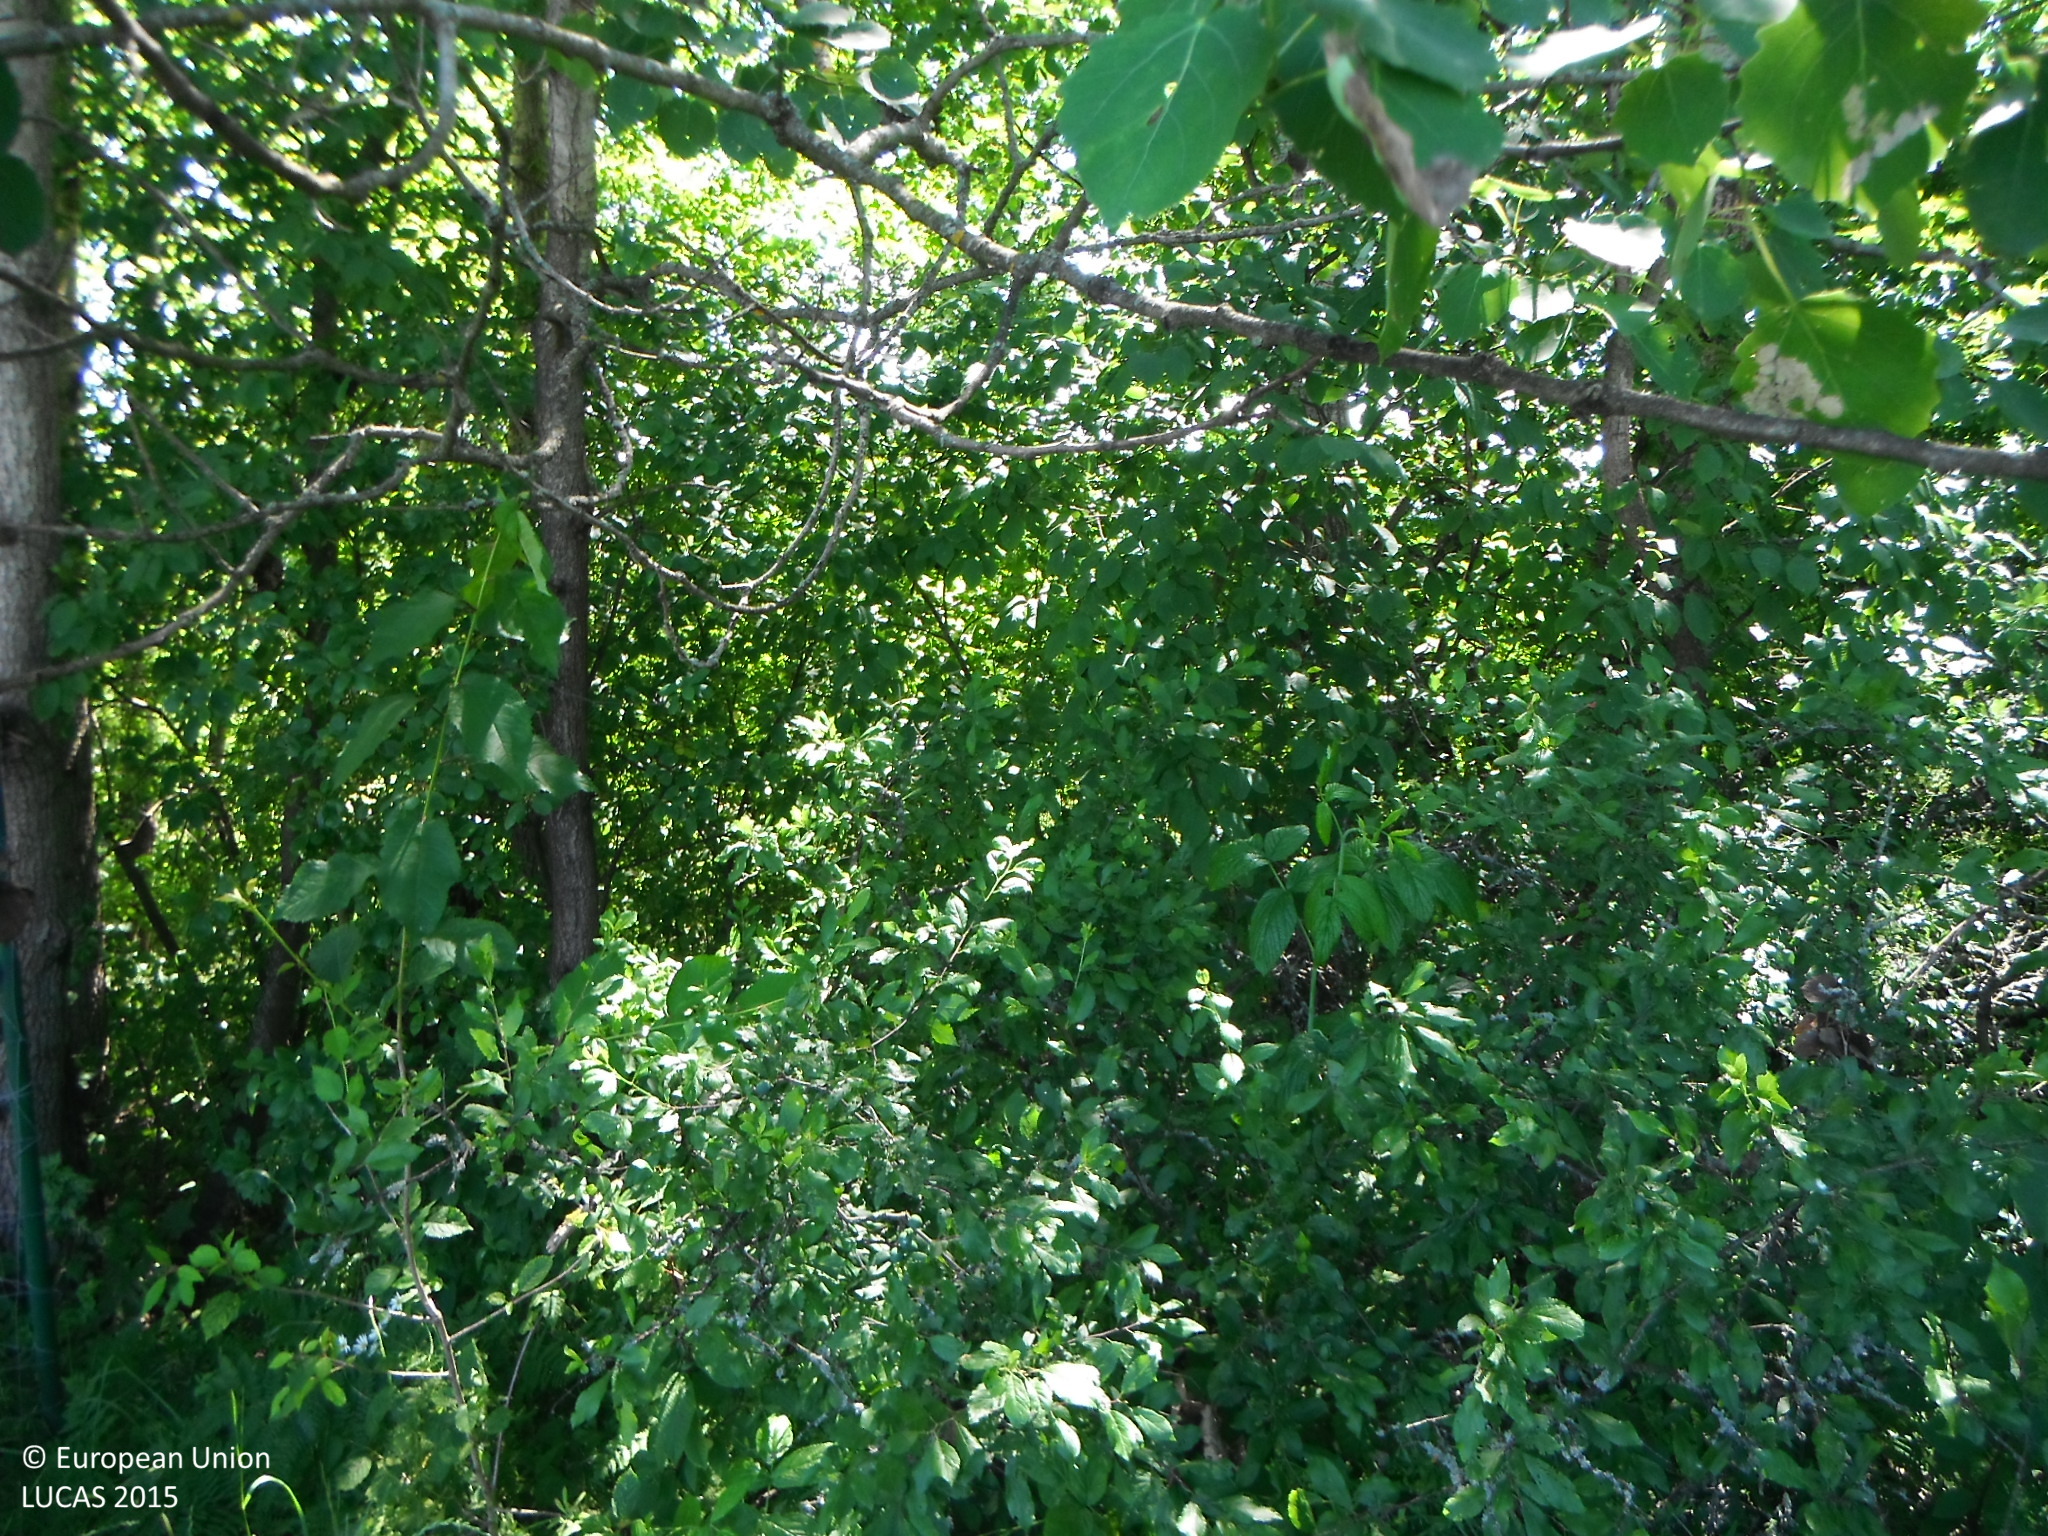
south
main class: Woodland
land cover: Broadleaved woodland
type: mesophytic deciduous forest
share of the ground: 50 - 75 %
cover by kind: broadleaved forest trees 60 %, herbaceous plants 40 %
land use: Forestry
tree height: > 5 m
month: July
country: SK
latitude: 48.9201
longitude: 20.6688
